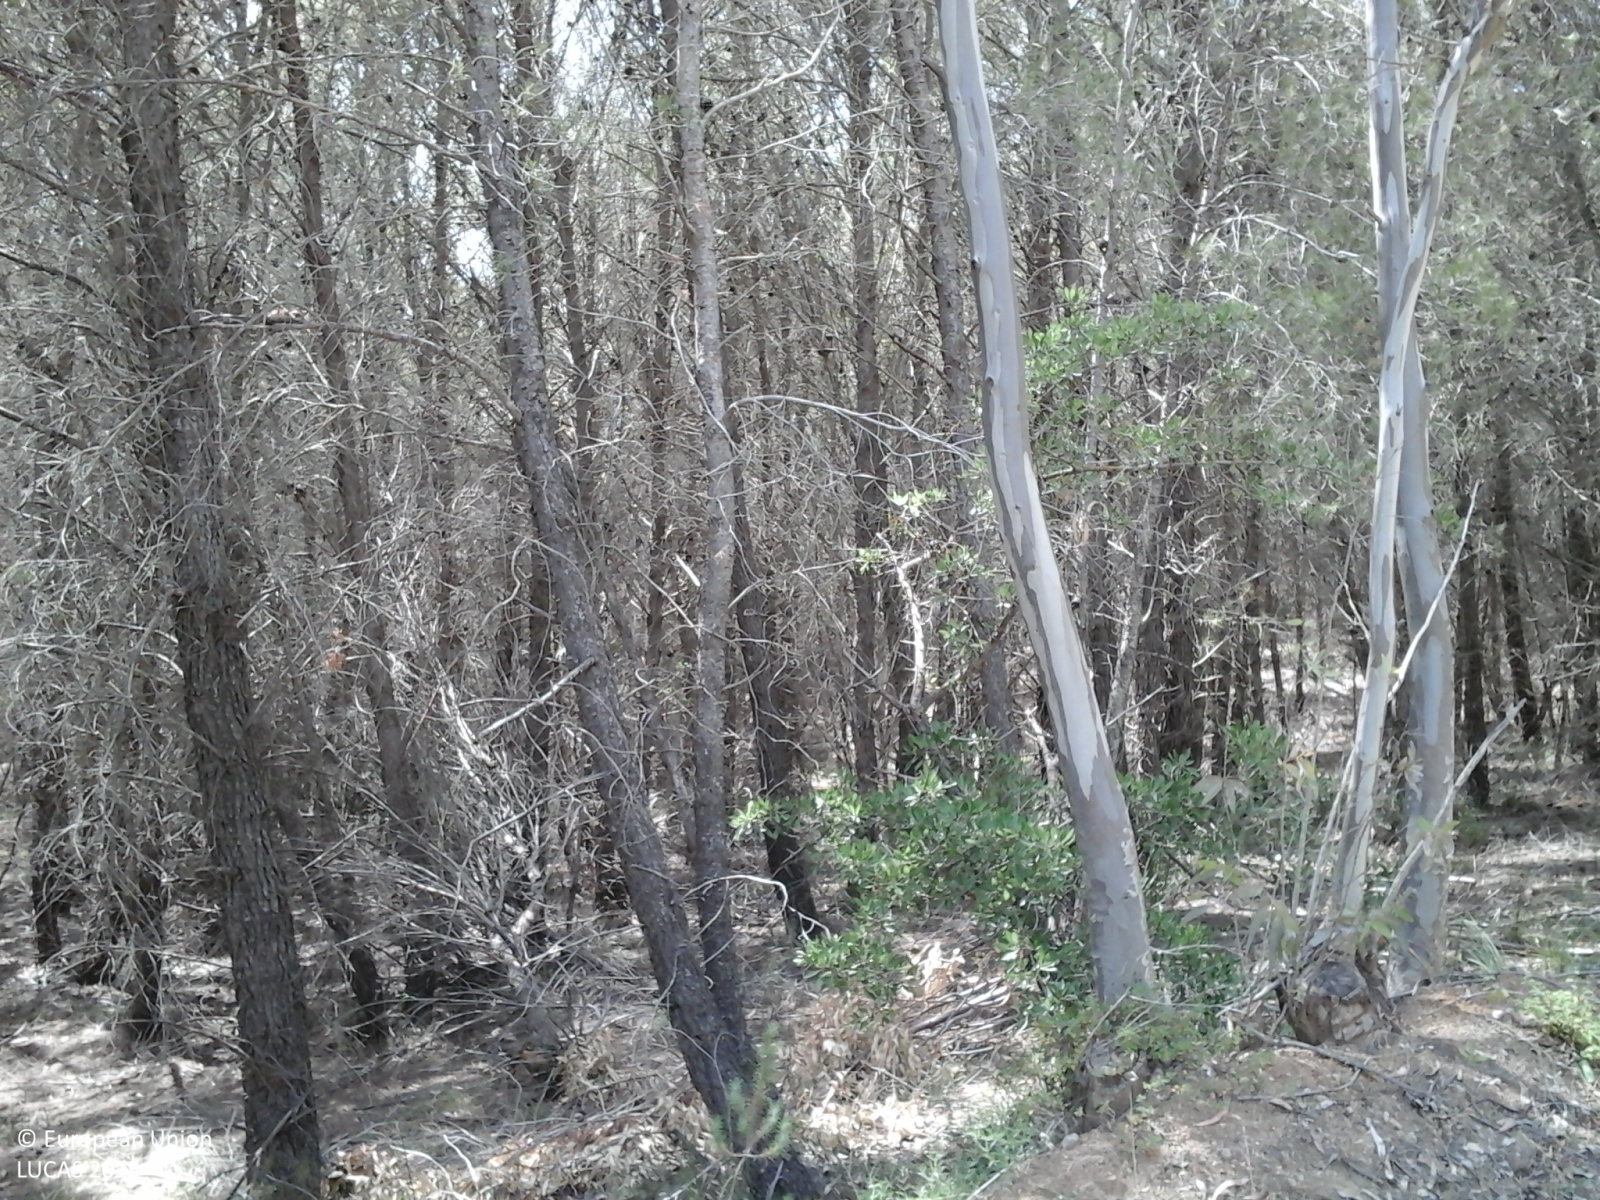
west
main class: Woodland
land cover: Broadleaved woodland
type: exotic forest
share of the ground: > 75 %
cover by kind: broadleaved forest trees 100 %
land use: Forestry
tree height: > 5 m
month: May
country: IT
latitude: 37.3194
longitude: 14.3790
